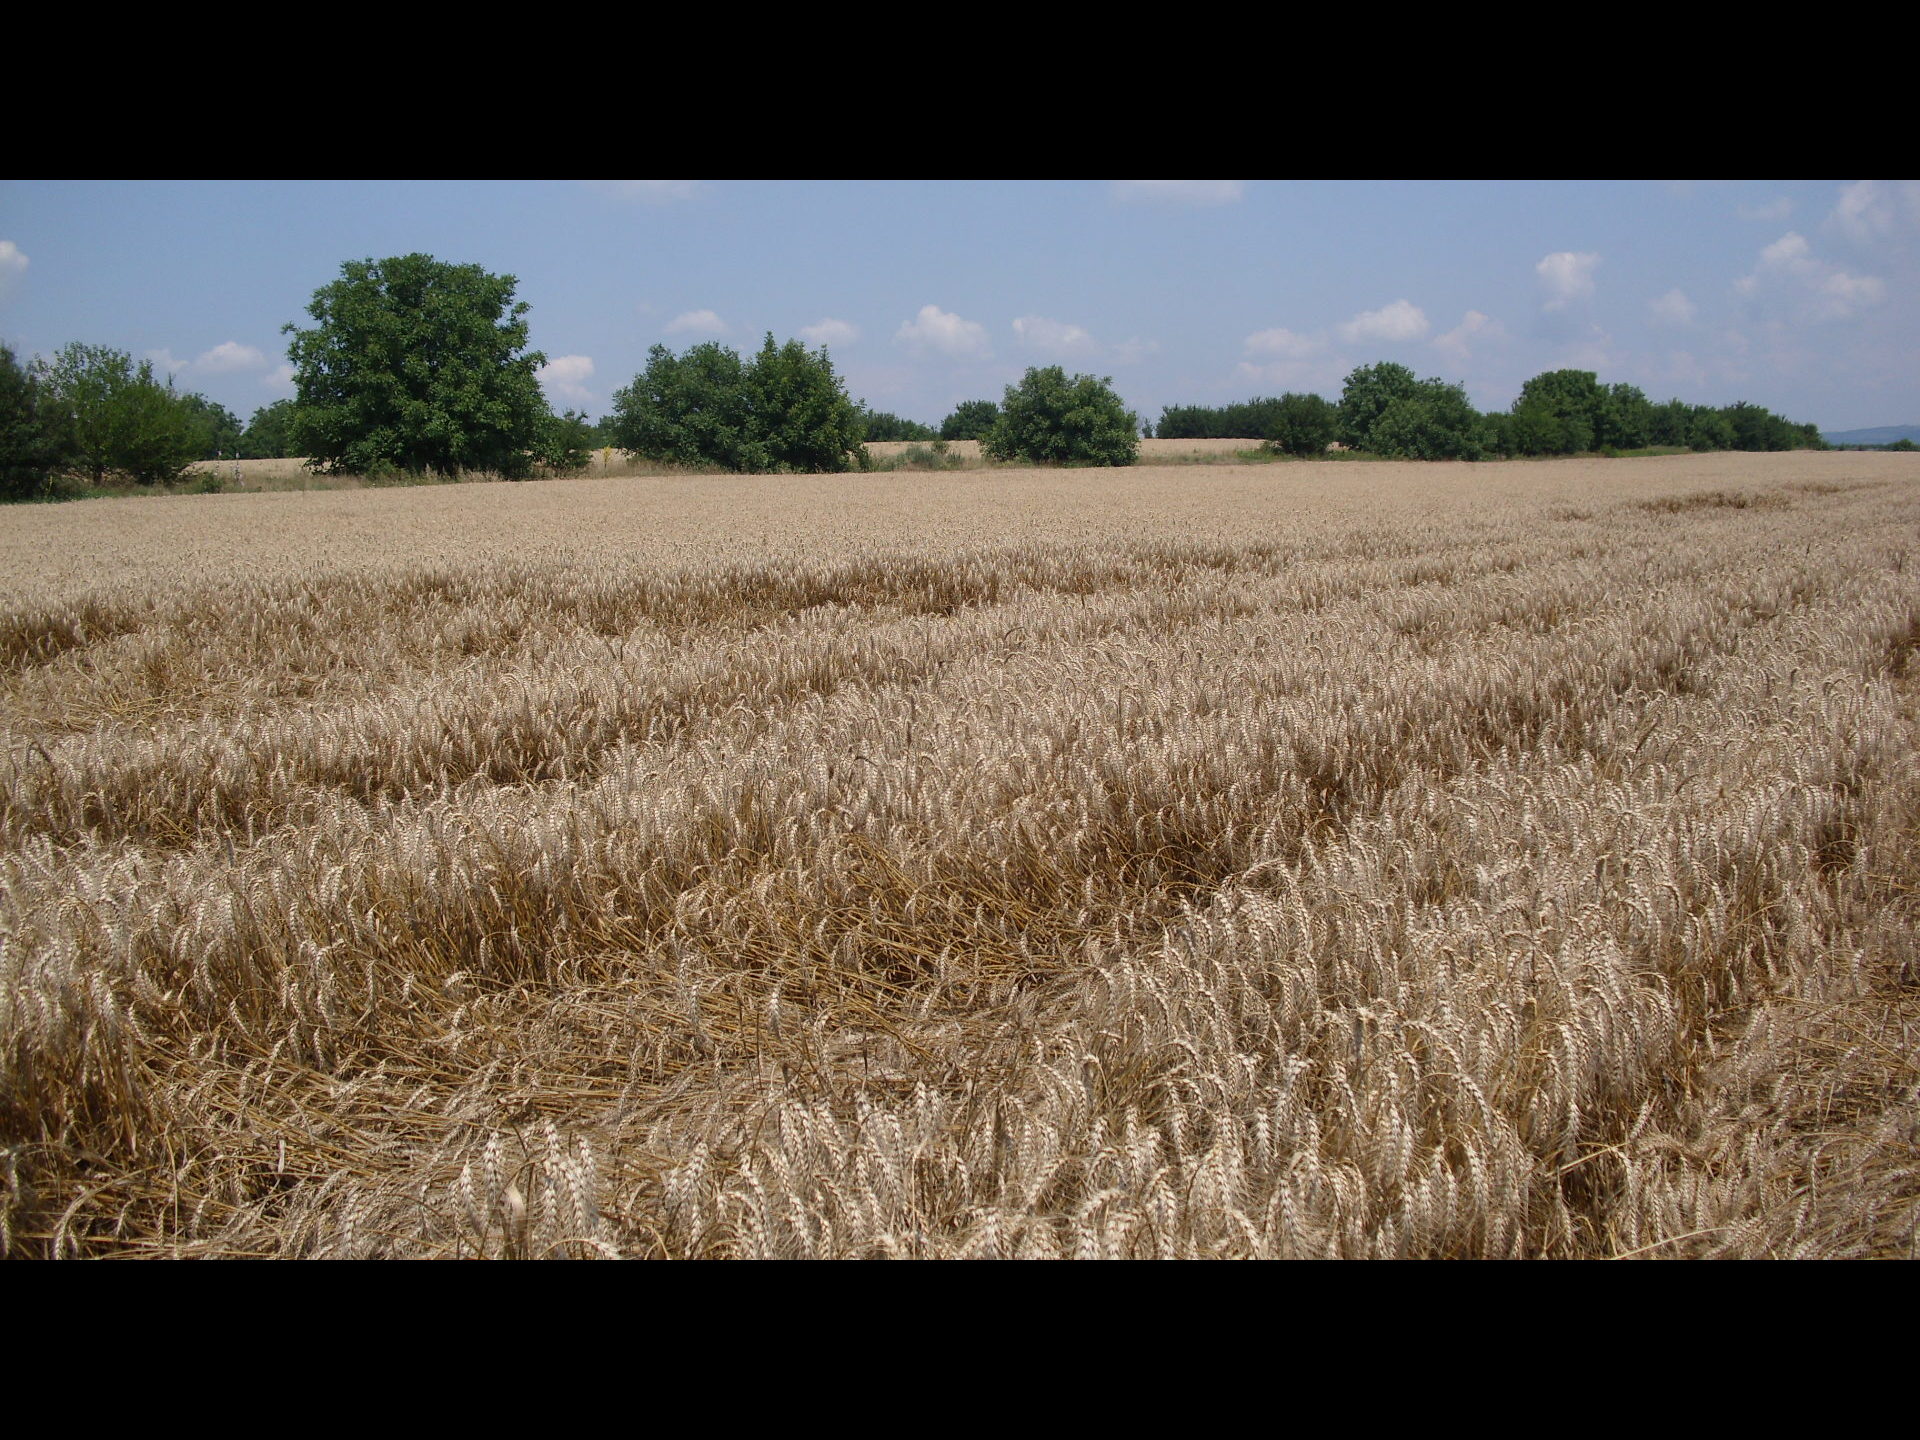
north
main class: Cropland
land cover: Common wheat
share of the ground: > 75 %
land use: Agriculture (excluding fallow land and kitchen gardens)
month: July
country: BG
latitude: 43.7593
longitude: 23.1959
